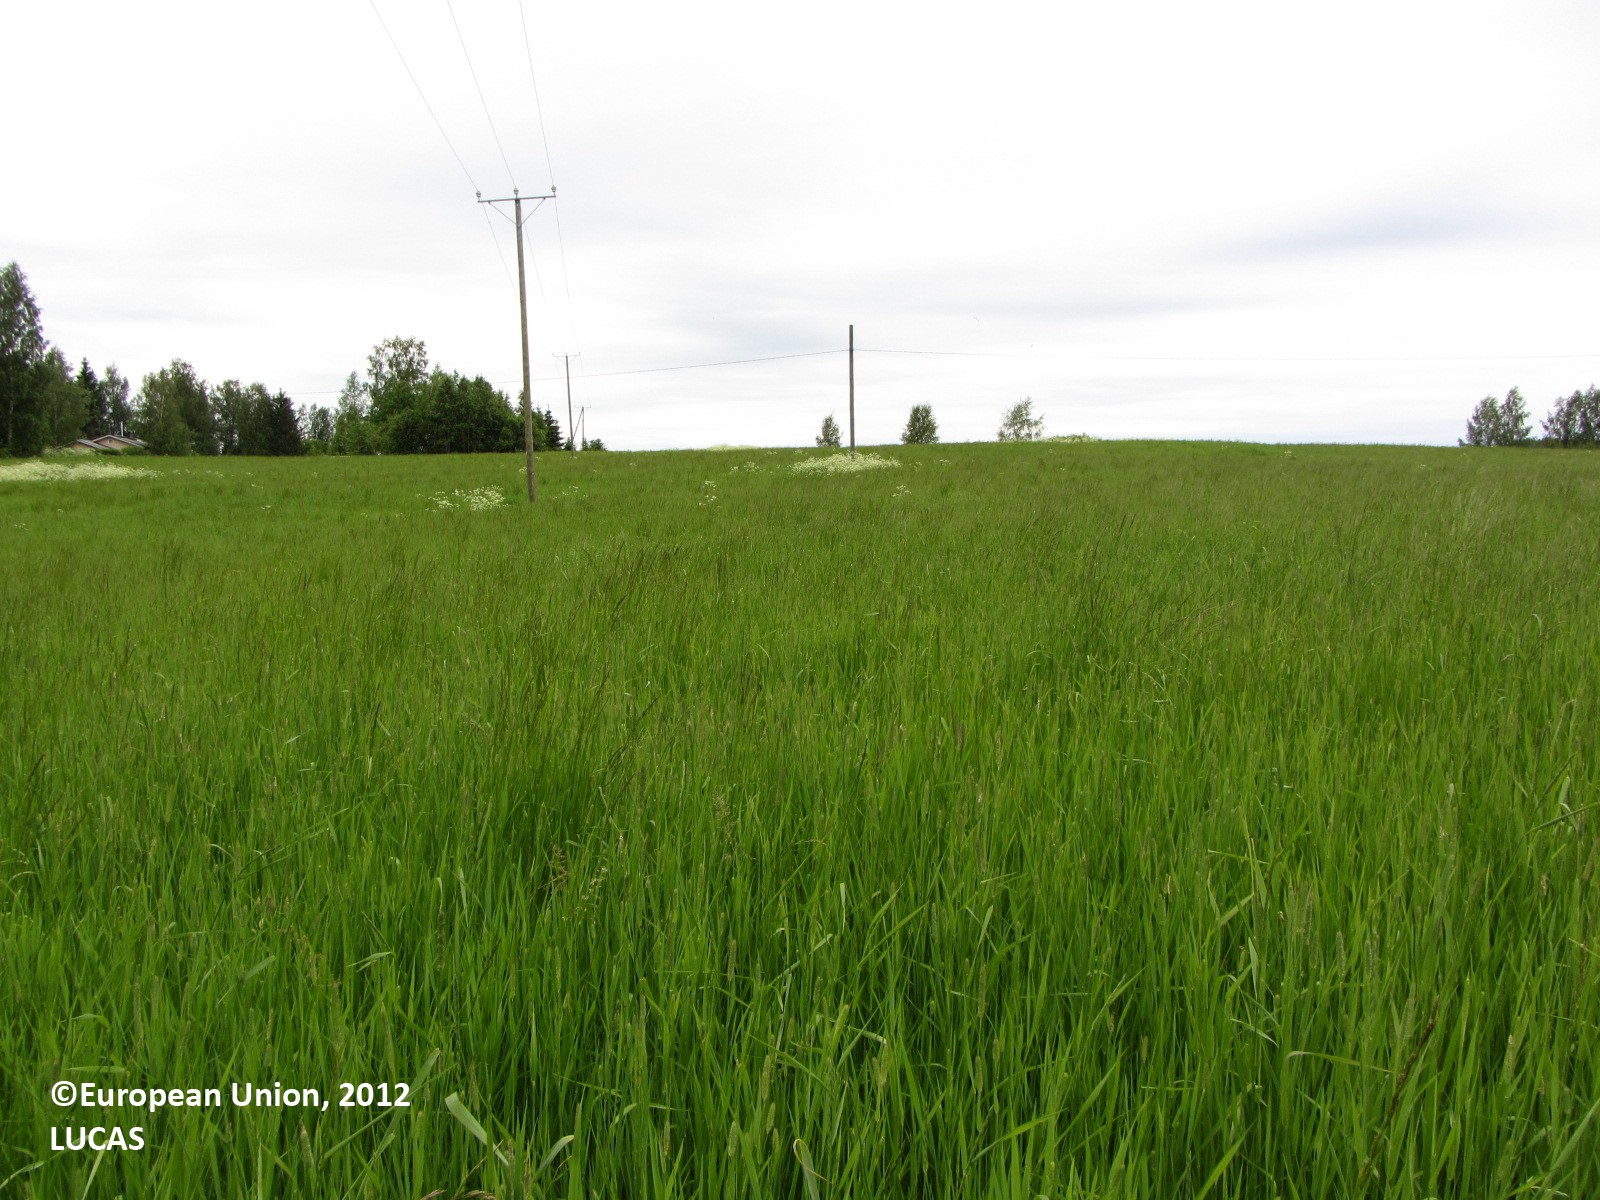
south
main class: Cropland
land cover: Temporary grasslands
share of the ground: > 75 %
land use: Agriculture (excluding fallow land and kitchen gardens)
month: June
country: FI
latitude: 62.6972
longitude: 25.0488
